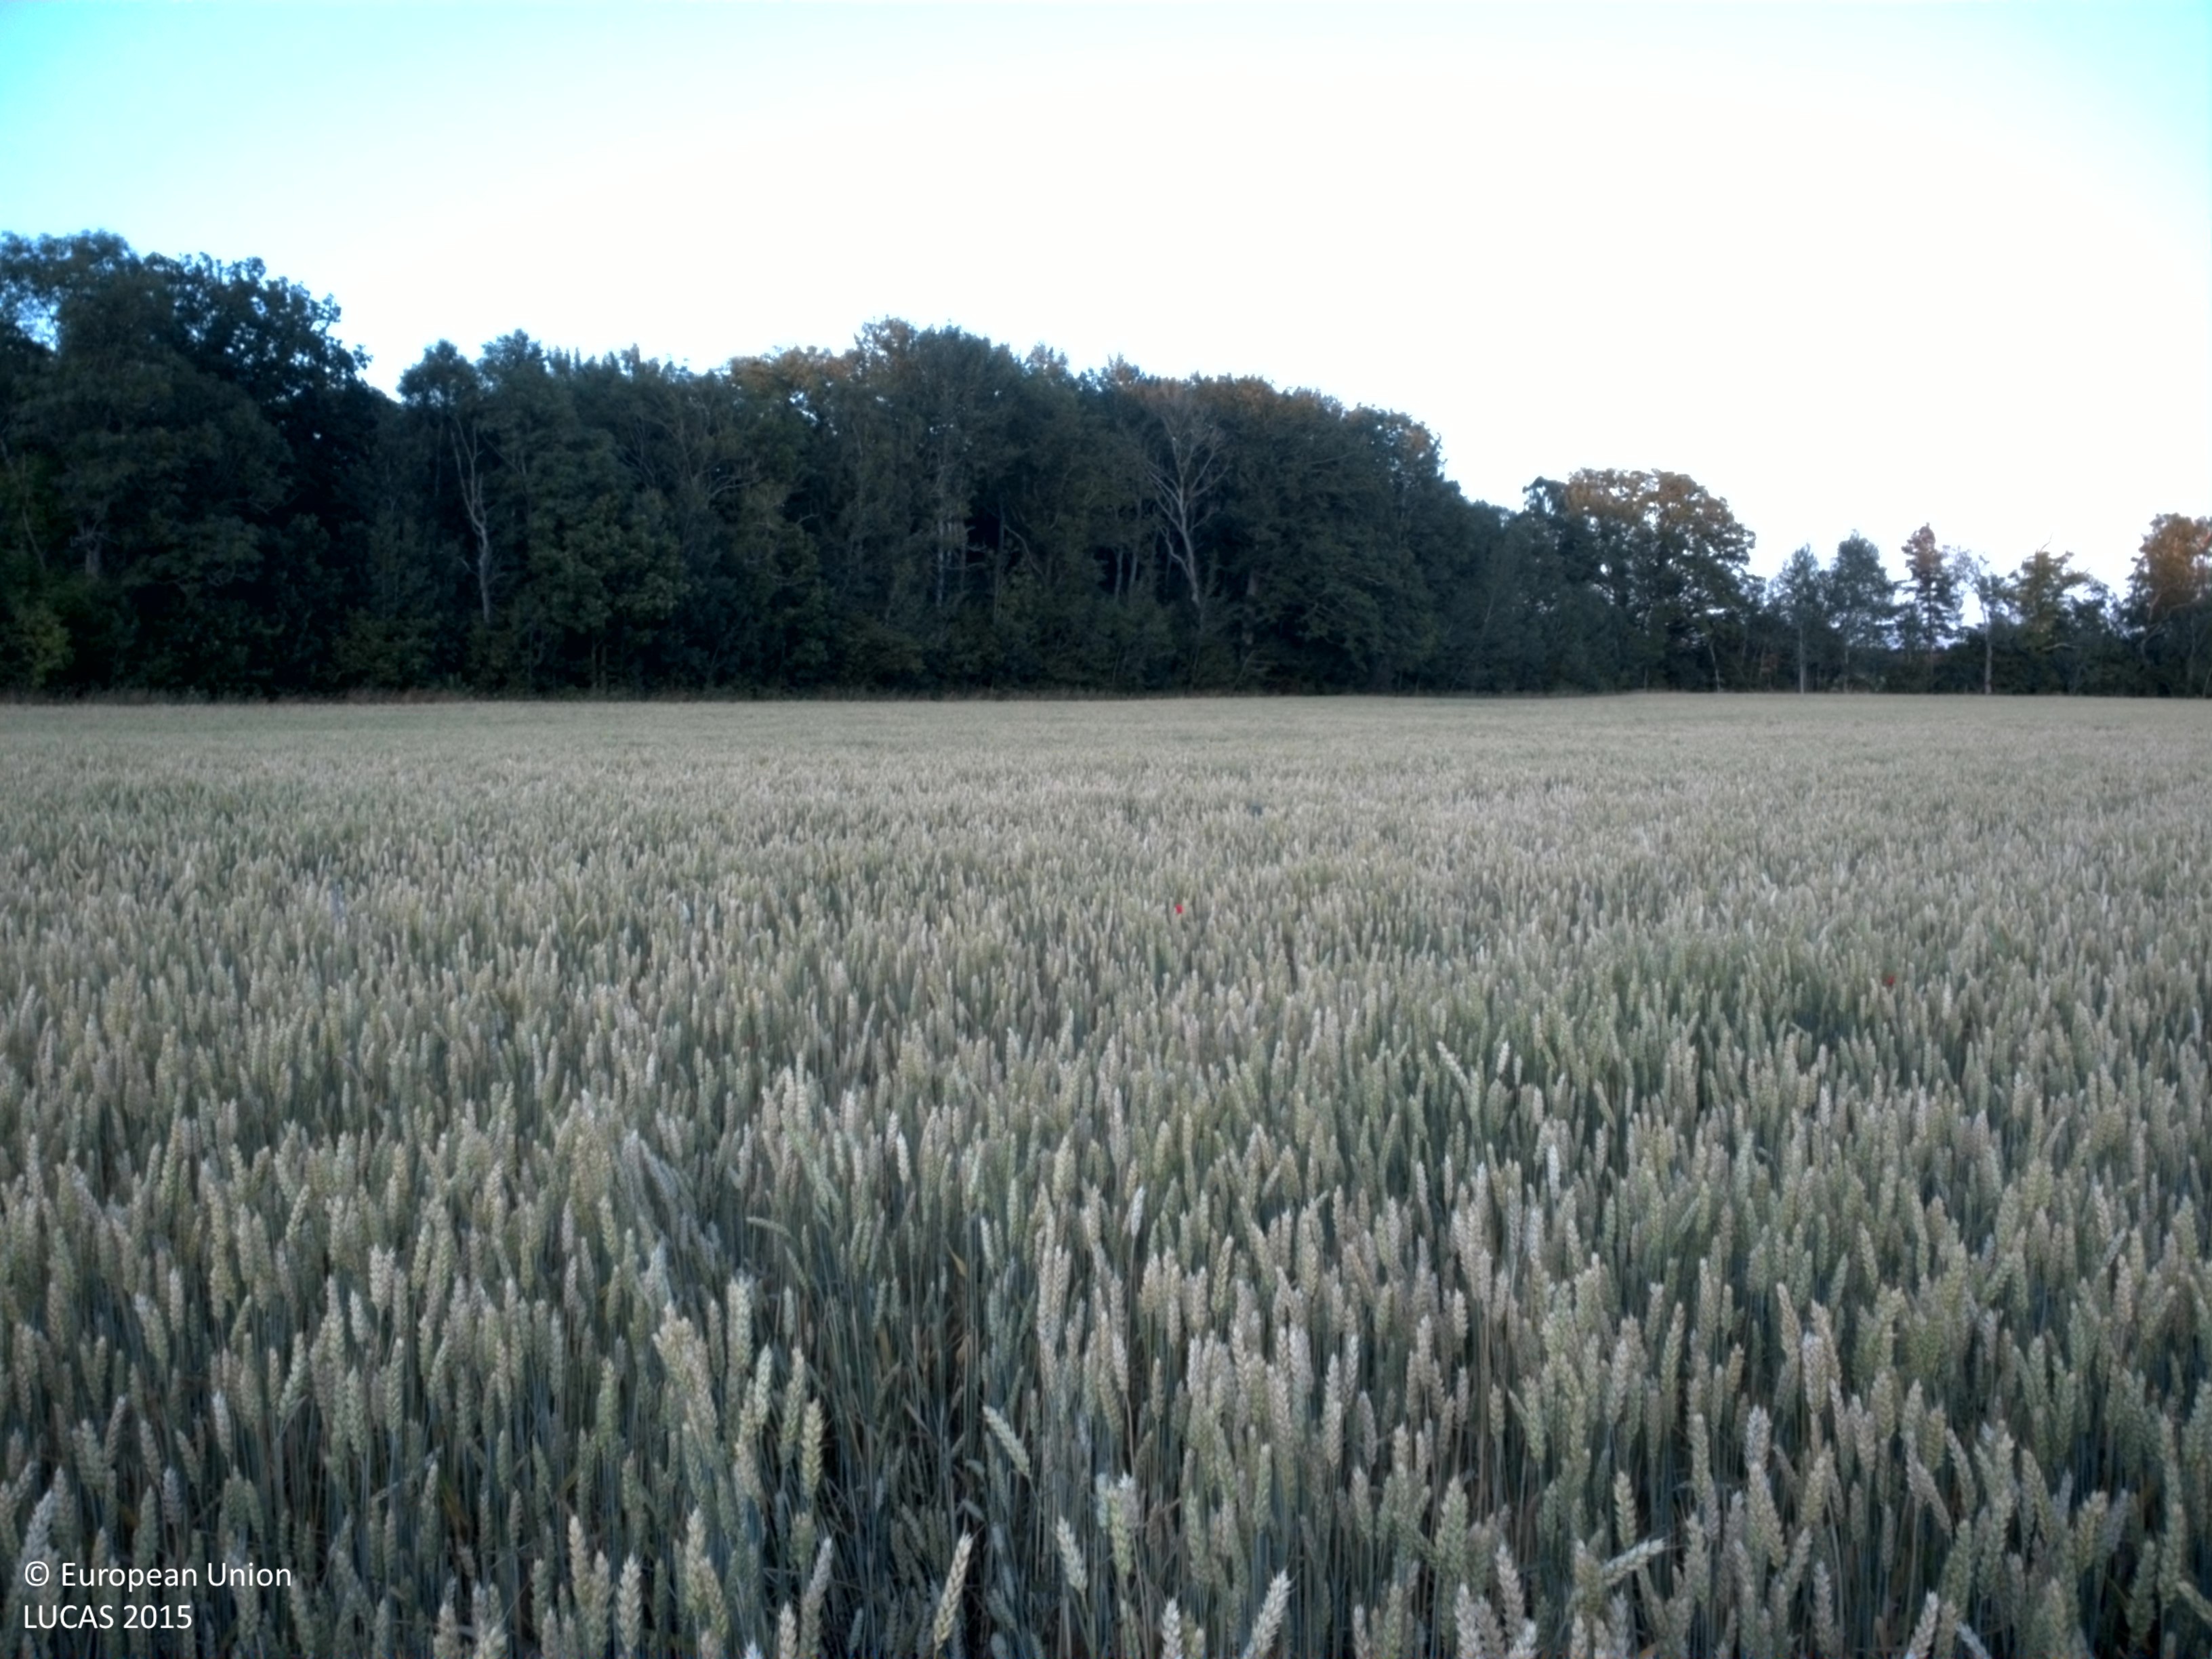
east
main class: Cropland
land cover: Common wheat
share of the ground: > 75 %
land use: Agriculture (excluding fallow land and kitchen gardens)
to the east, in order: Common wheat; Ditches and canals; Broadleaved woodland; Other mixed woodland; Rivers and streams; Other mixed woodland
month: July
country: SE
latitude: 57.2835
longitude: 18.4529
